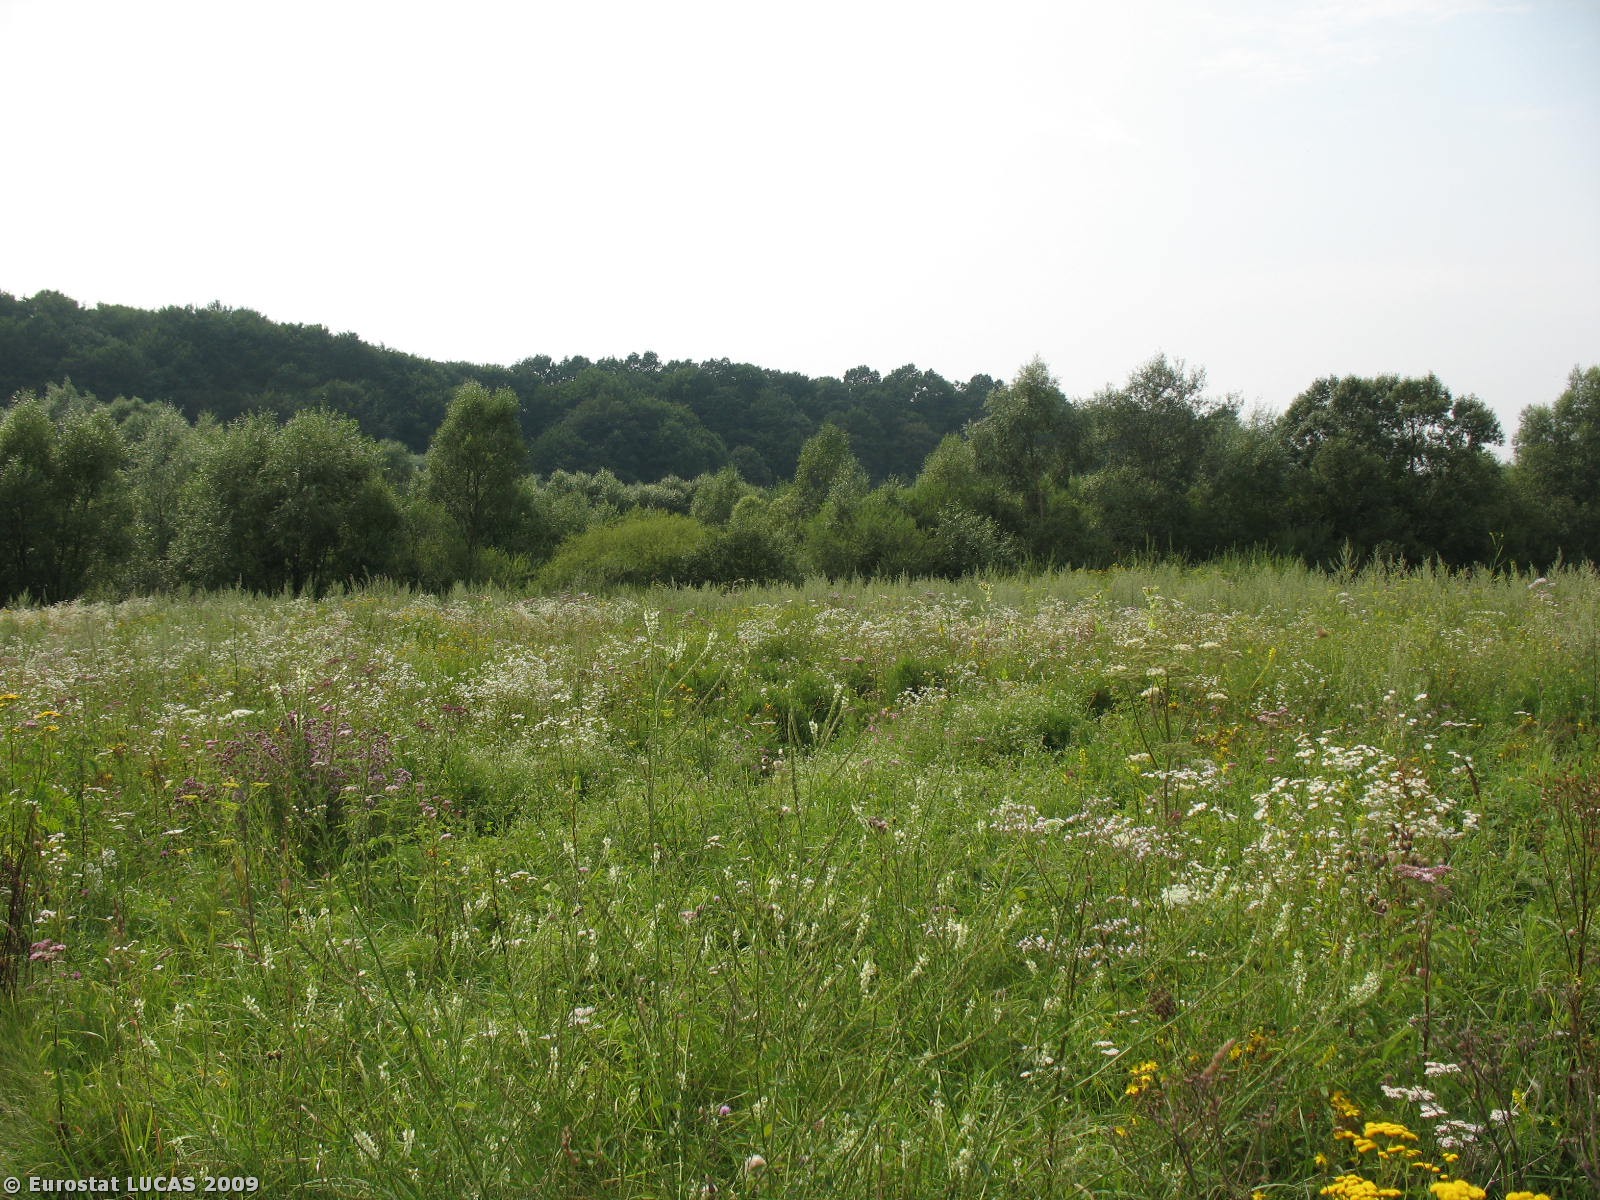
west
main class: Grassland
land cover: Spontaneously vegetated surfaces
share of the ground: > 75 %
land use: Unused
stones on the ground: < 10 %
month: August
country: PL
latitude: 49.5405
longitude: 22.2352
